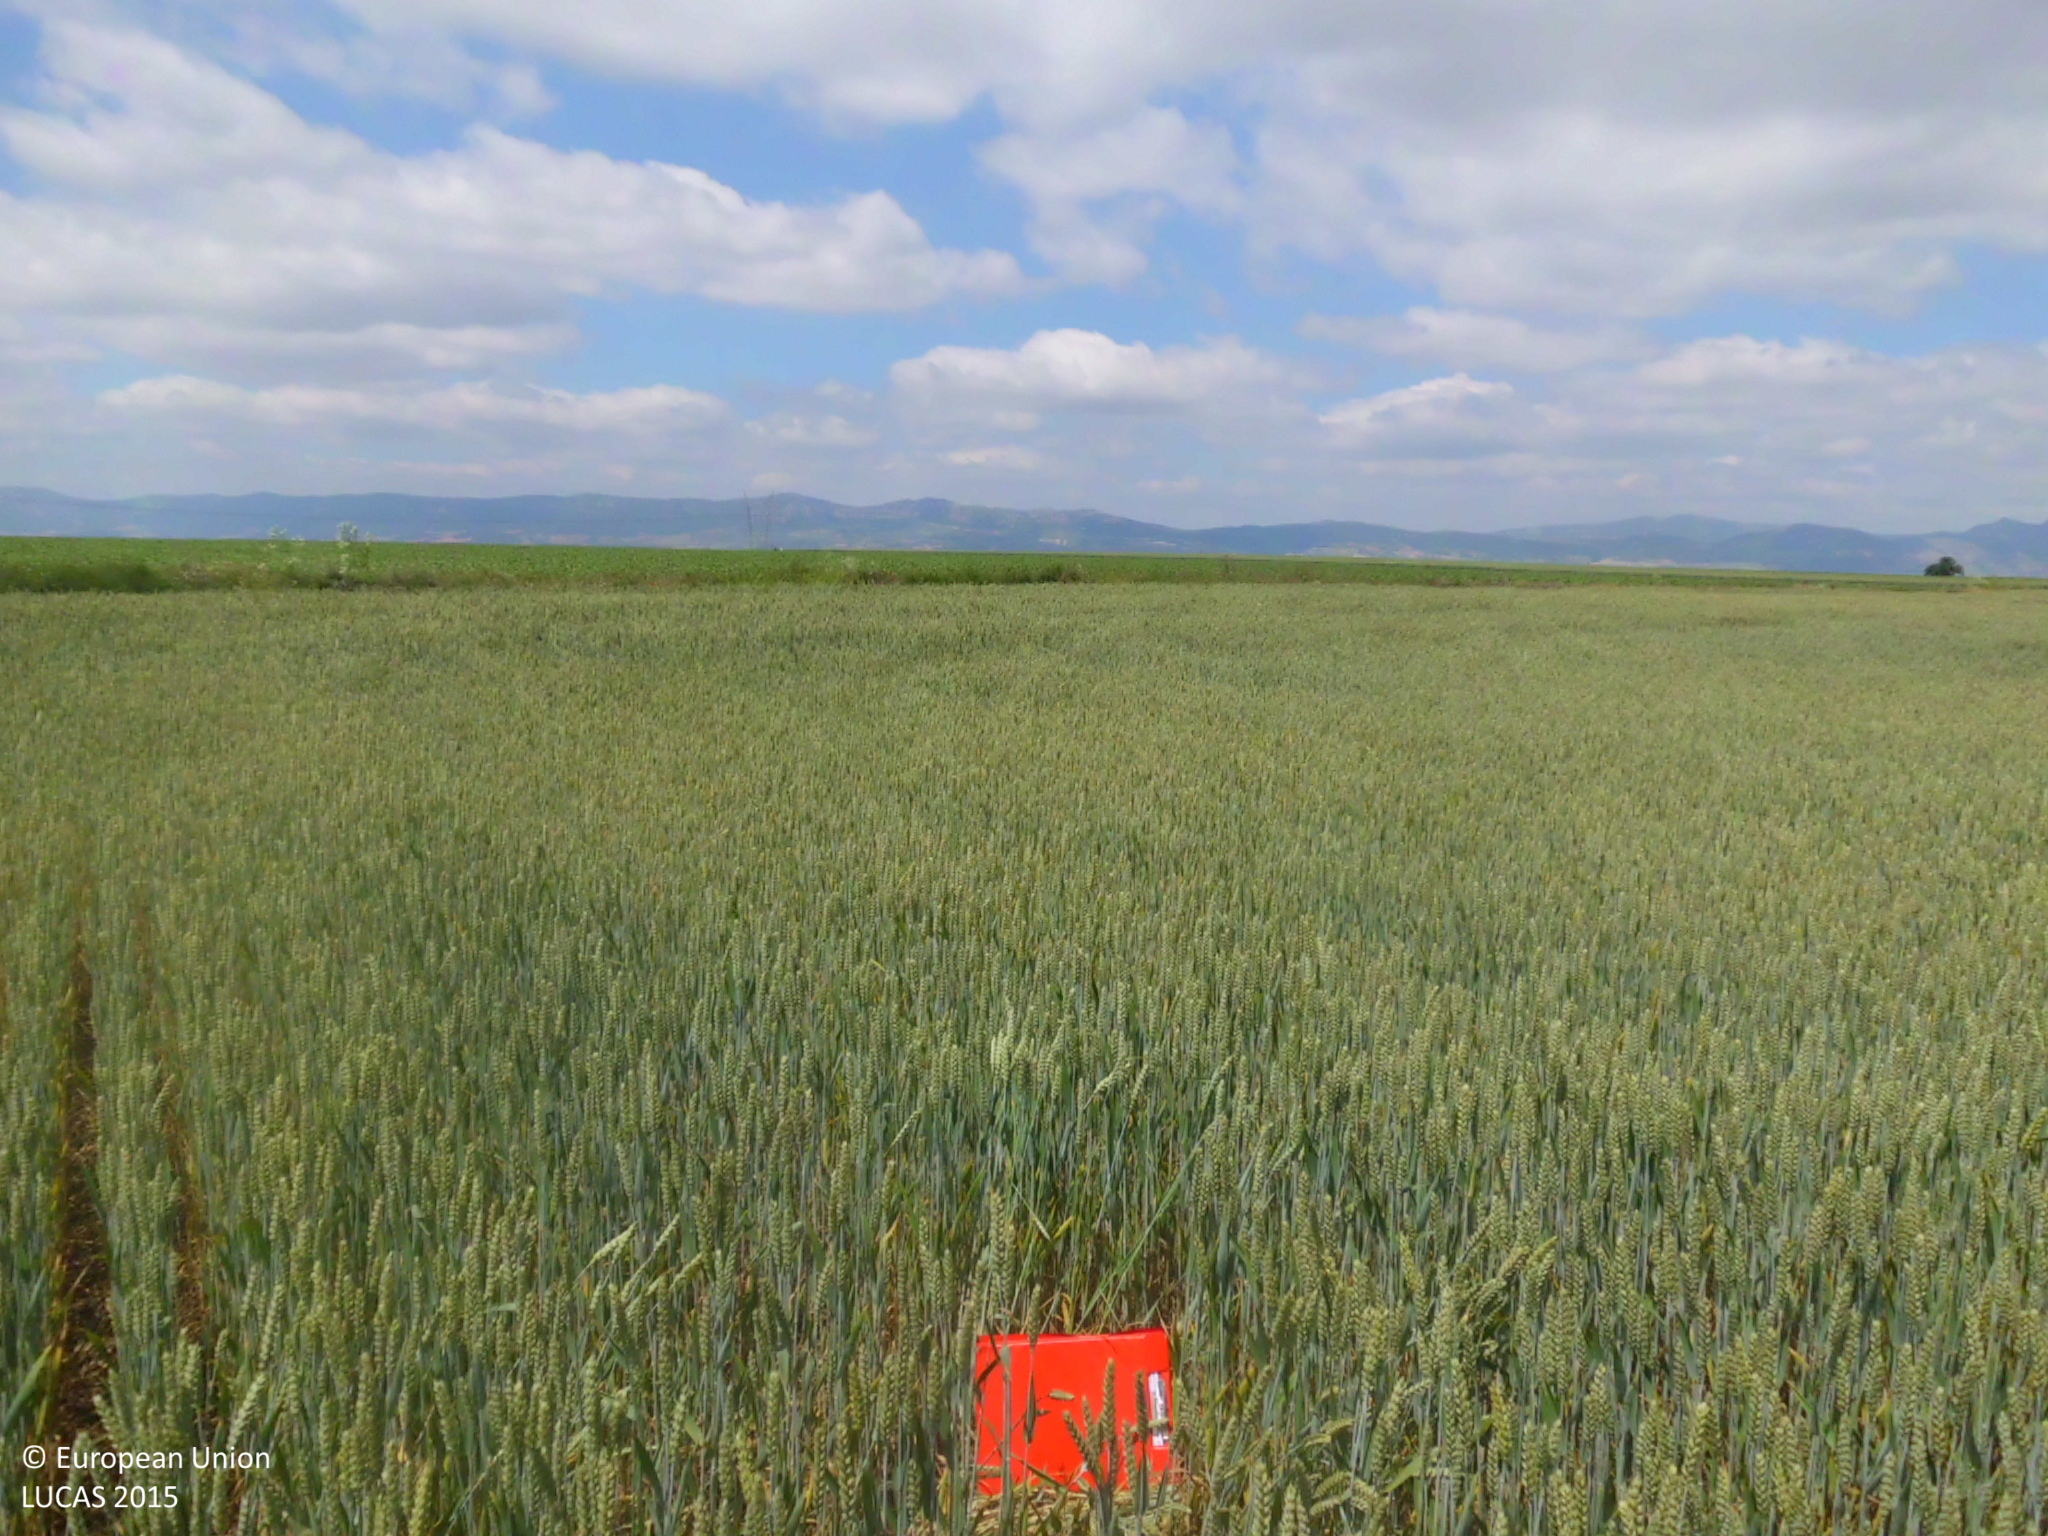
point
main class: Cropland
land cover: Common wheat
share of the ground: > 75 %
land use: Agriculture (excluding fallow land and kitchen gardens)
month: June
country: ES
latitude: 42.5799
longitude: -3.2765
